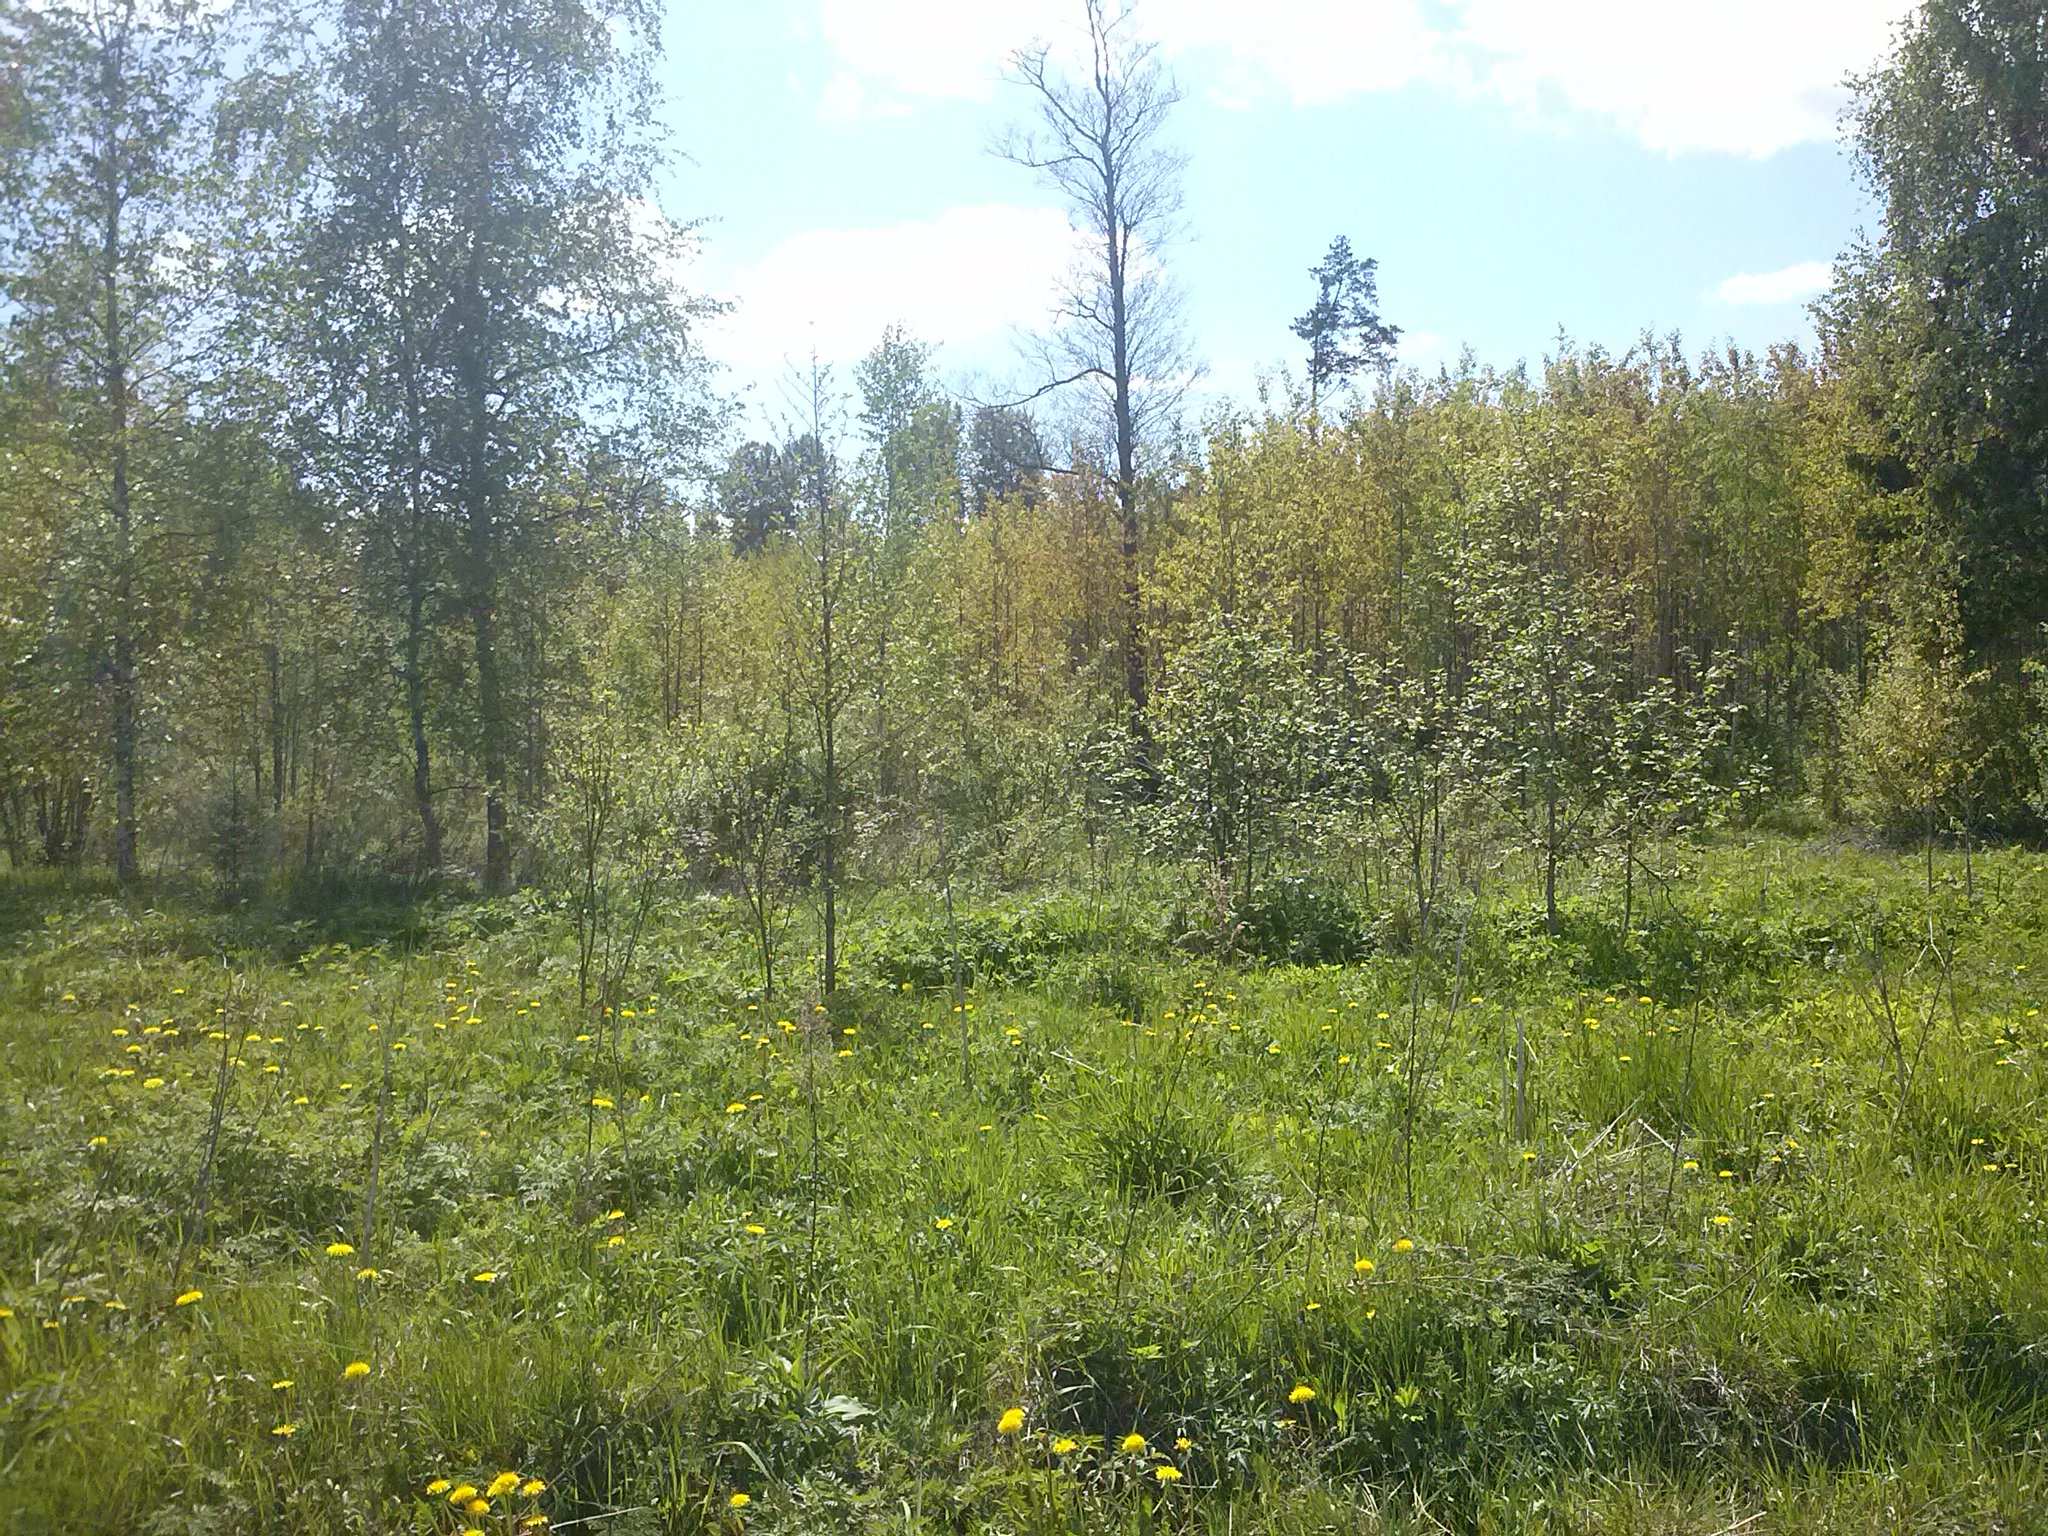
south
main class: Cropland
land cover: Rye
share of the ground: 10 - 25 %
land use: Agriculture (excluding fallow land and kitchen gardens)
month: May
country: LV
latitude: 56.1188
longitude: 27.6037
